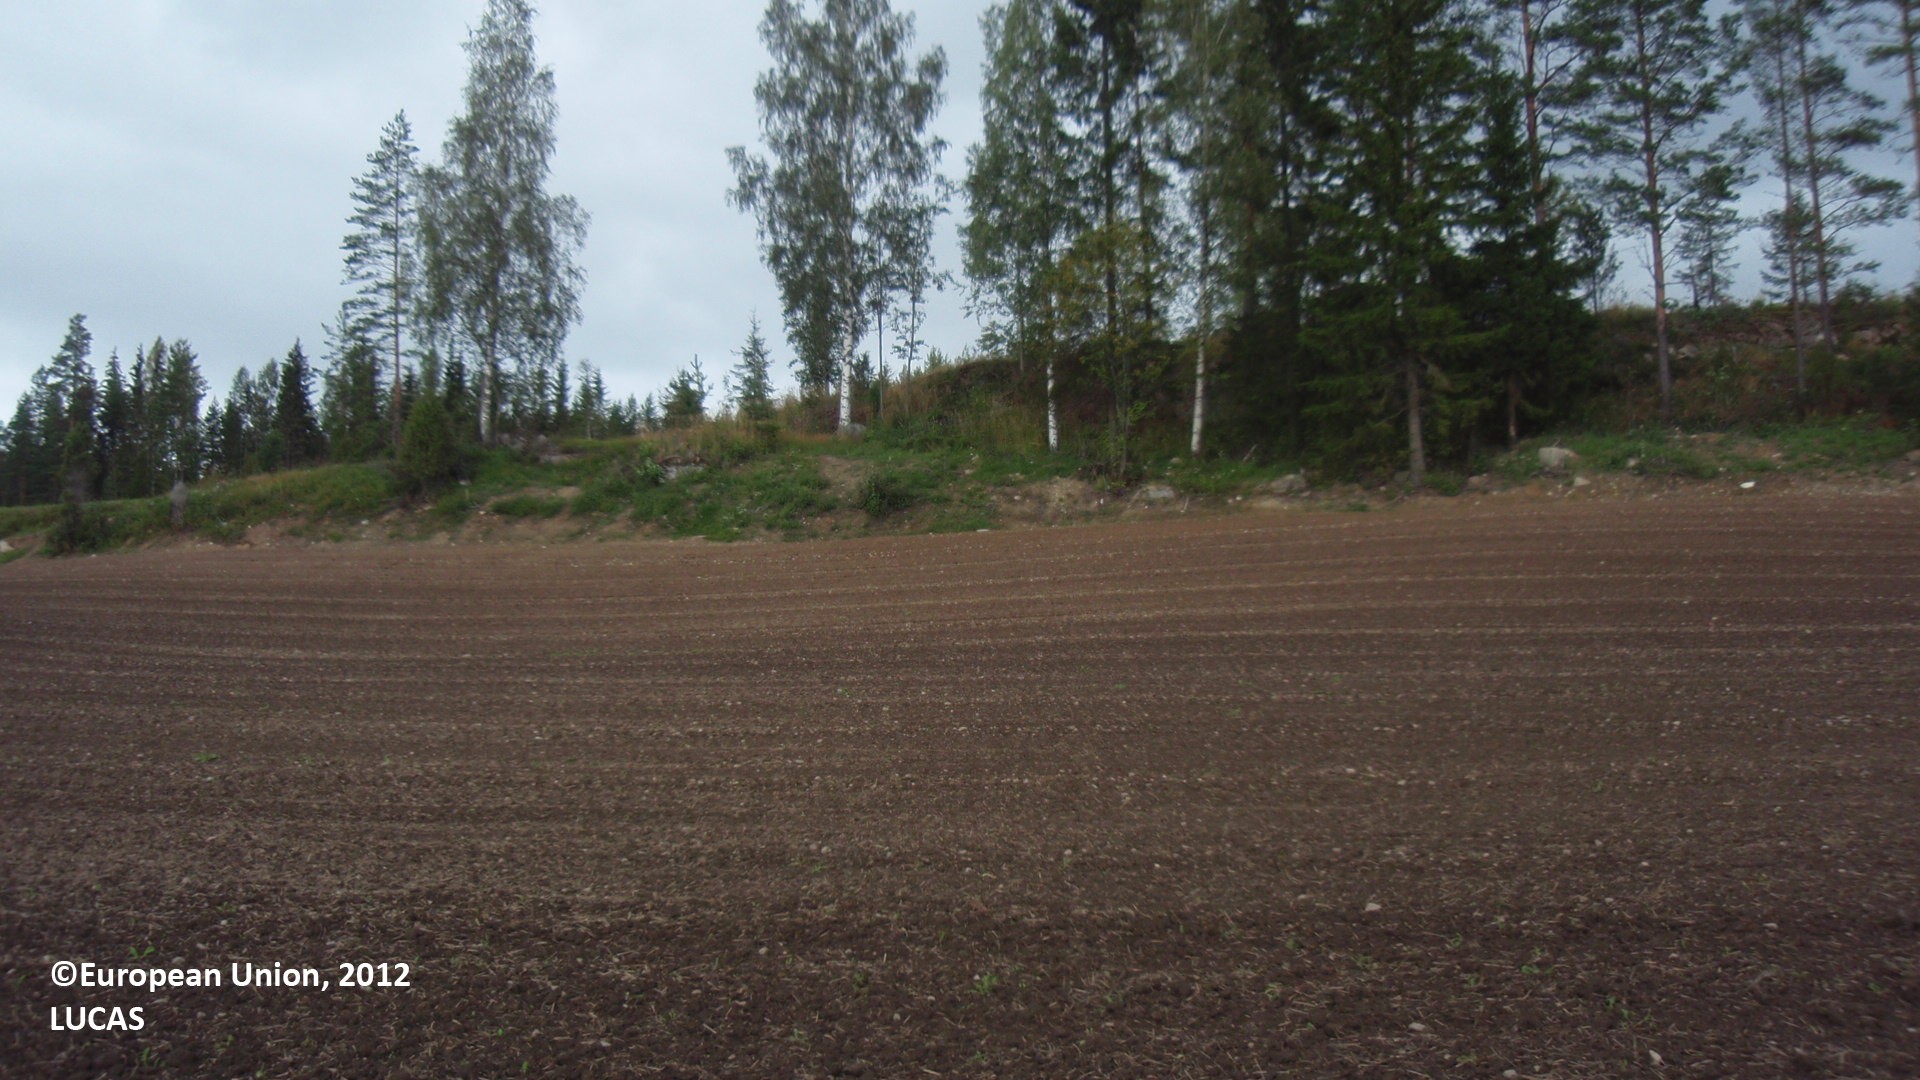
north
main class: Cropland
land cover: Oats
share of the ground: > 75 %
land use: Agriculture (excluding fallow land and kitchen gardens)
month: August
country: FI
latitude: 61.0115
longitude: 27.0946
